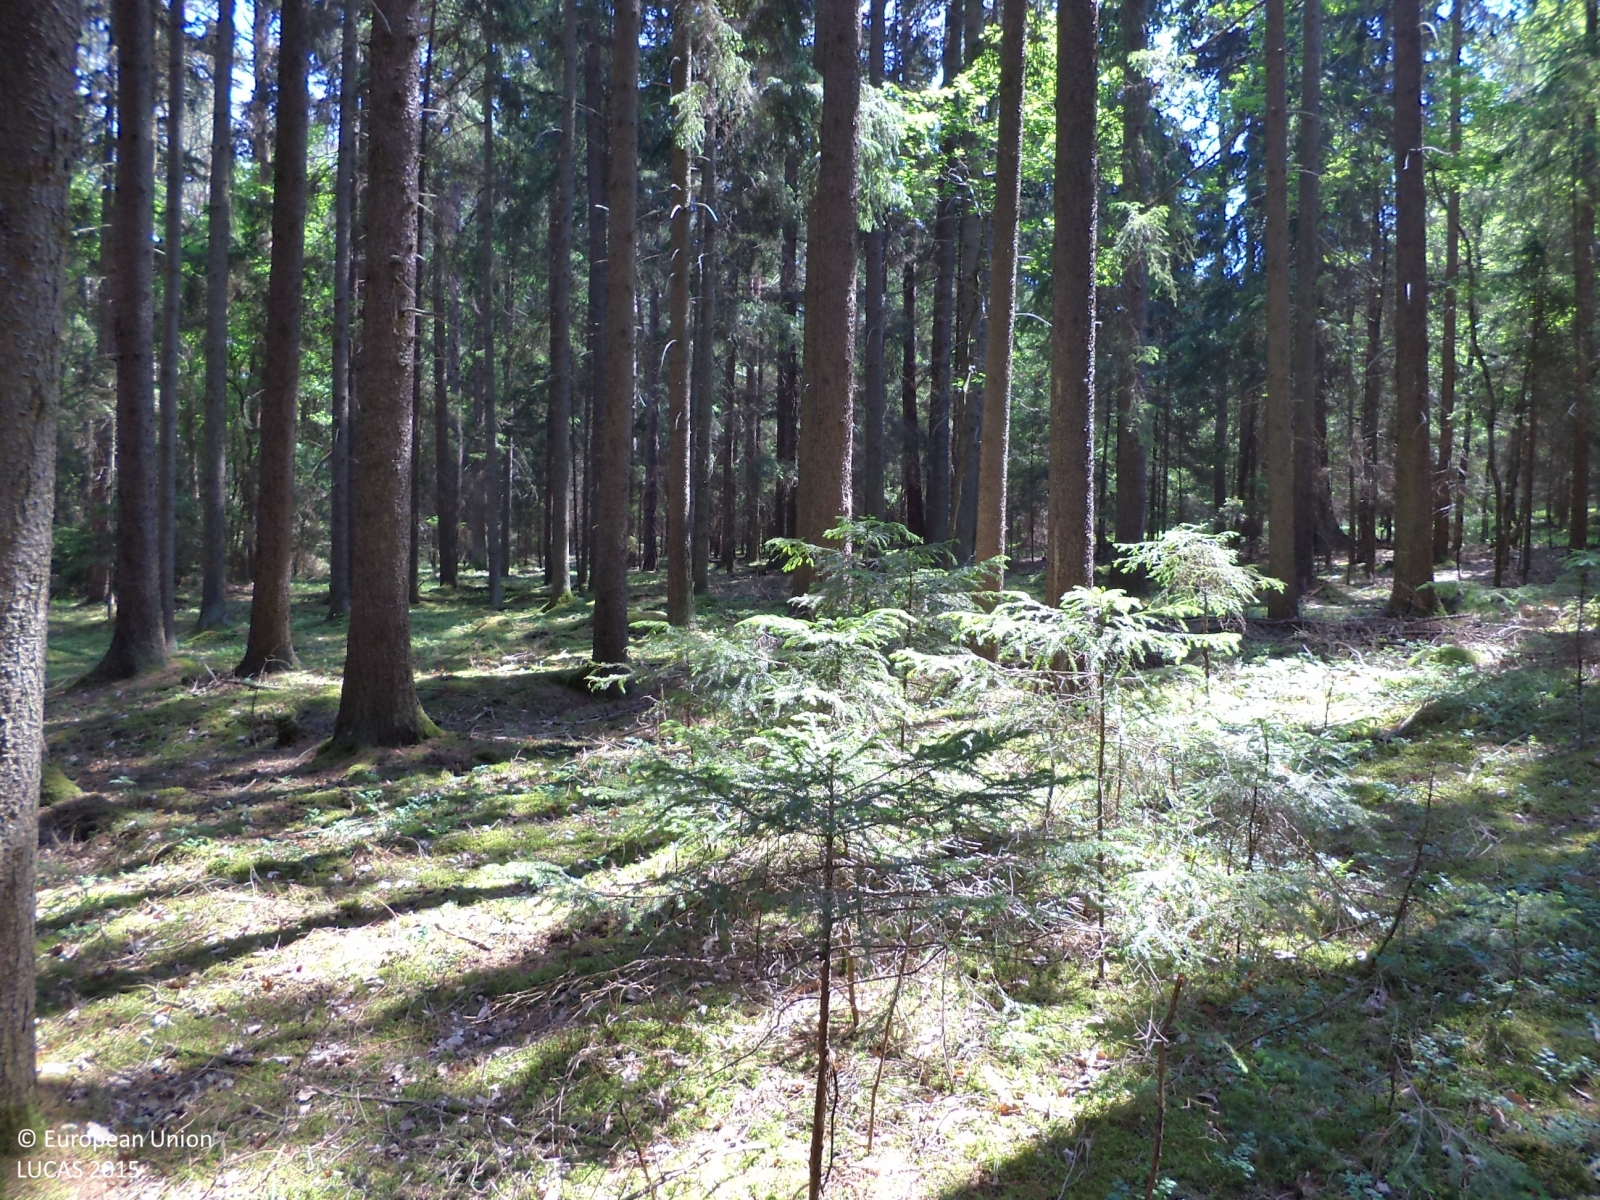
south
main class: Woodland
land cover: Spruce dominated coniferous woodland
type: hemiboreal forest and nemoral coniferous forest and mixed broadleaved-coniferous forest
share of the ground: > 75 %
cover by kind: coniferous forest trees 95 %, lichens and mosses 5 %
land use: Forestry
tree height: > 5 m
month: June
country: CZ
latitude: 49.2703
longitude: 14.4129
